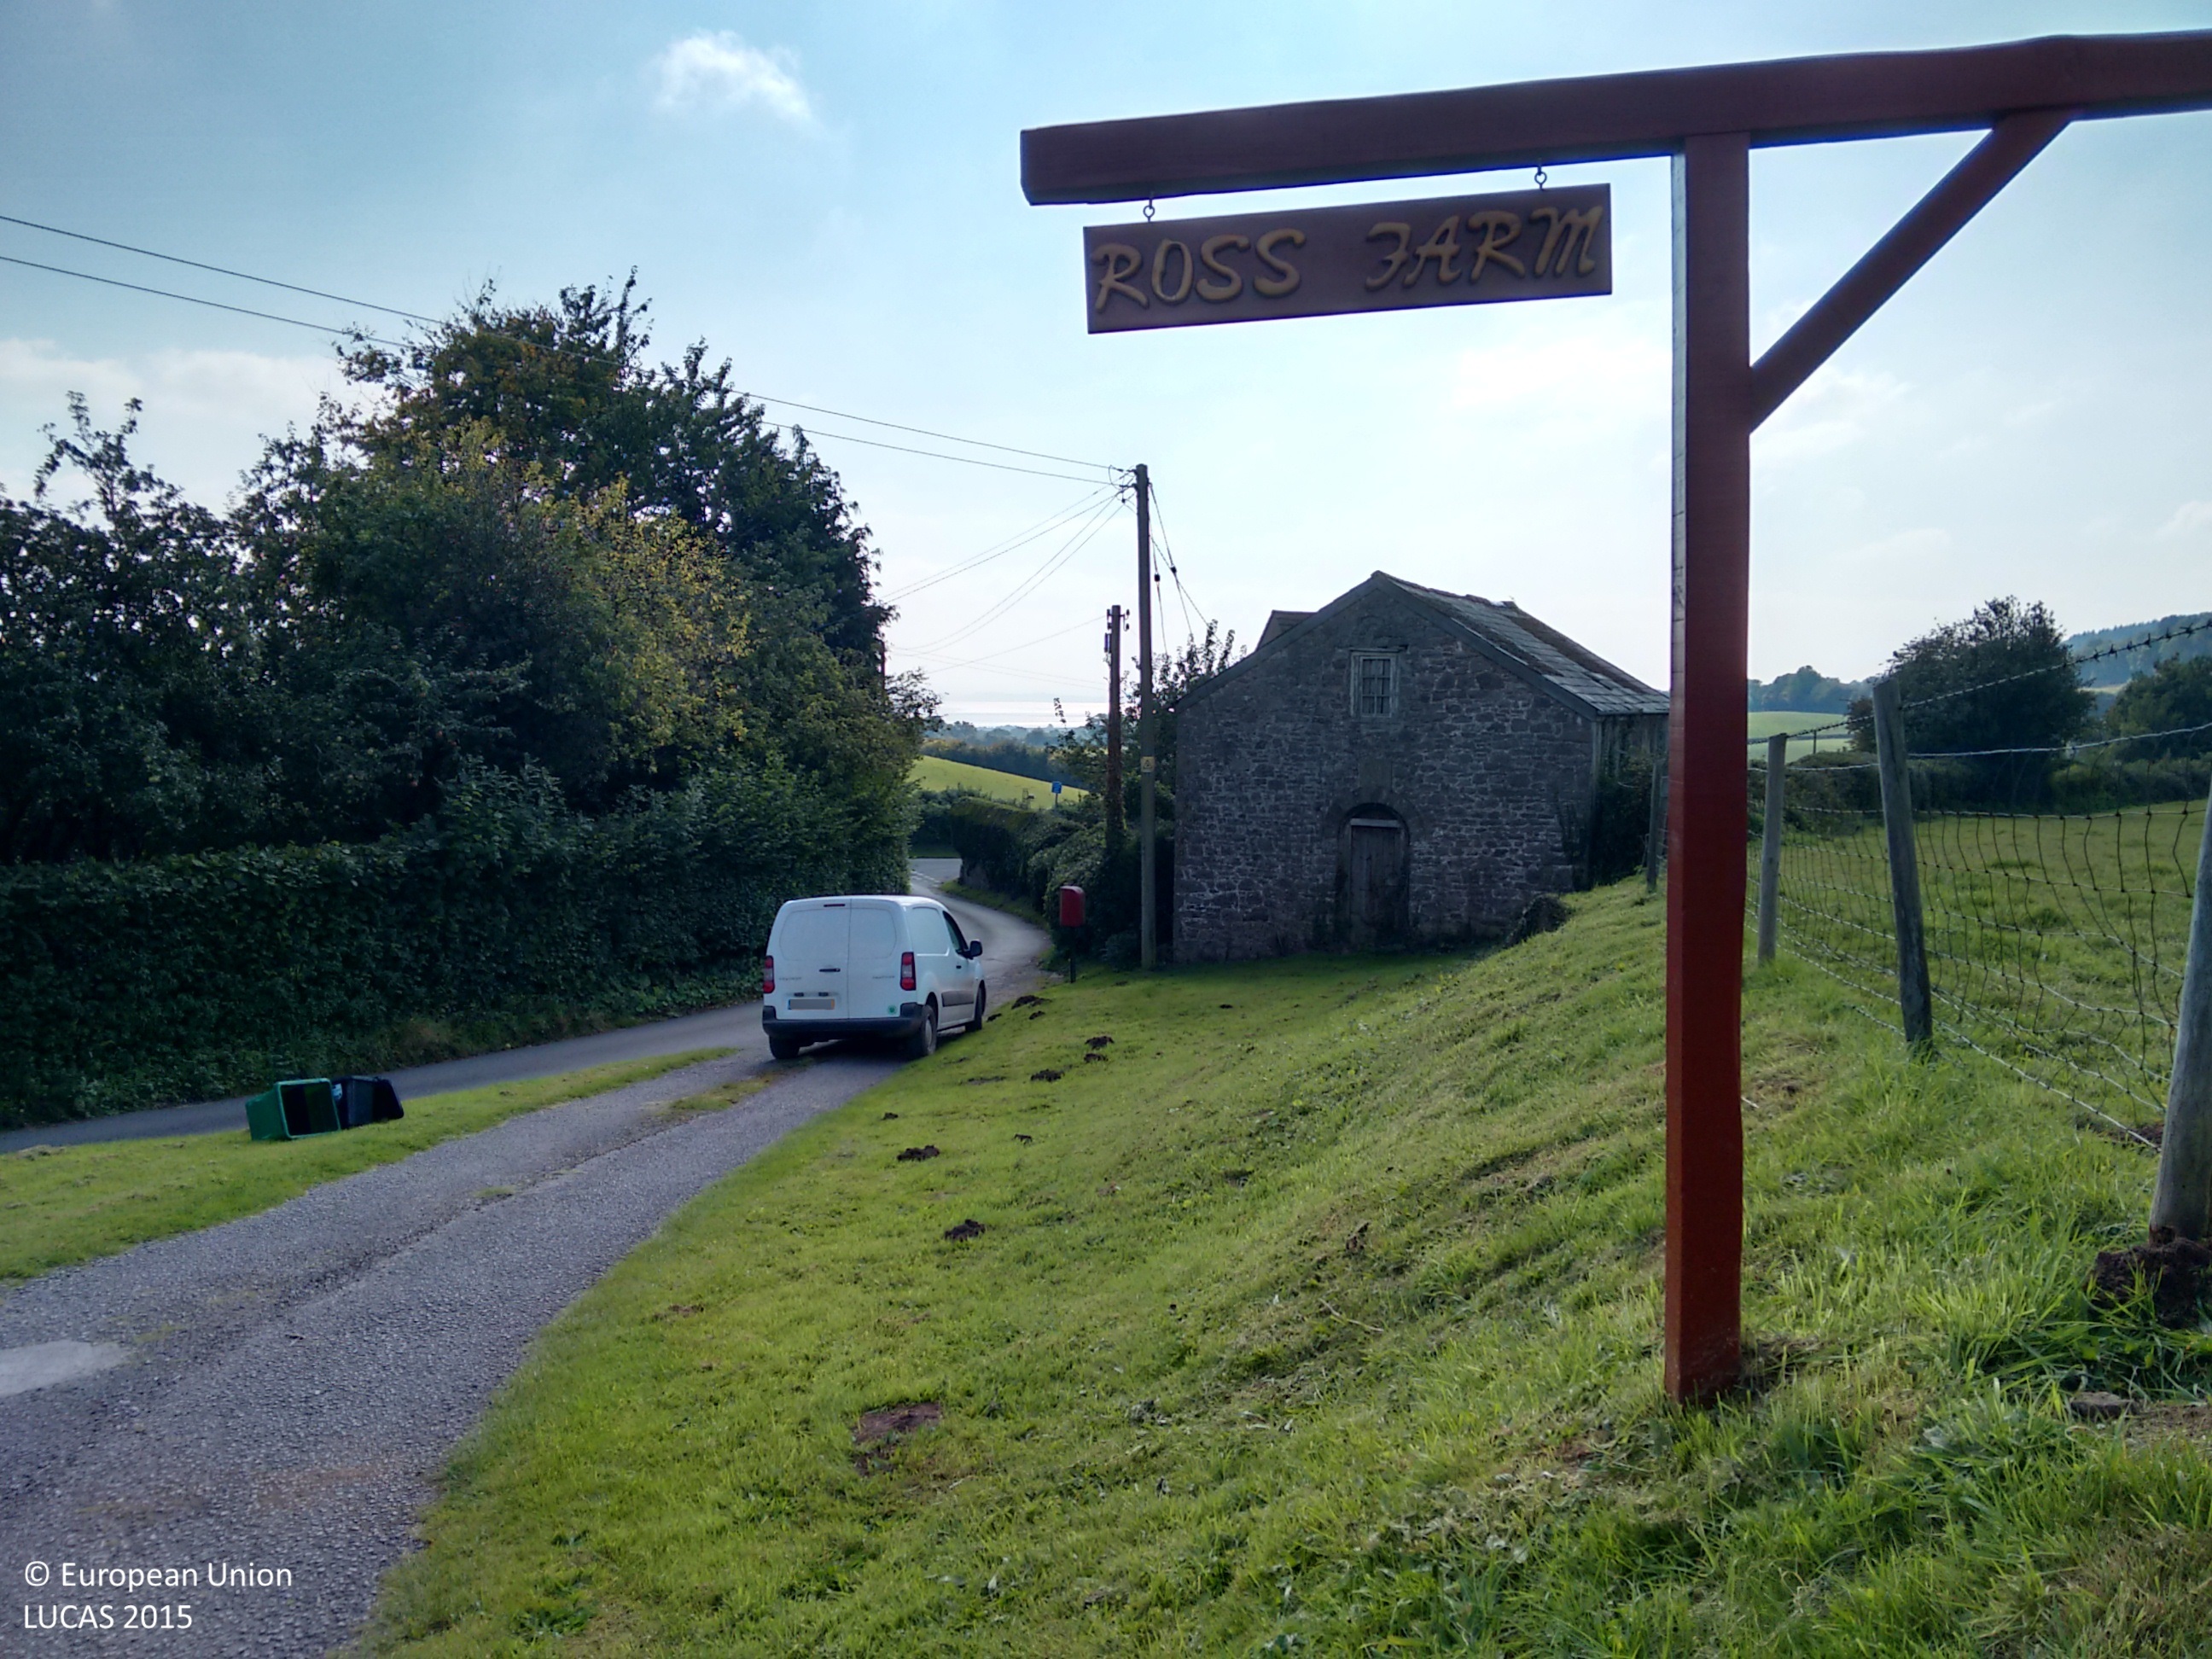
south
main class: Grassland
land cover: Grassland without tree/shrub cover
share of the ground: > 75 %
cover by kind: herbaceous plants 100 %
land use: Agriculture (excluding fallow land and kitchen gardens)
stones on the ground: < 10 %
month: October
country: GB
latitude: 51.7013
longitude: -2.6134
